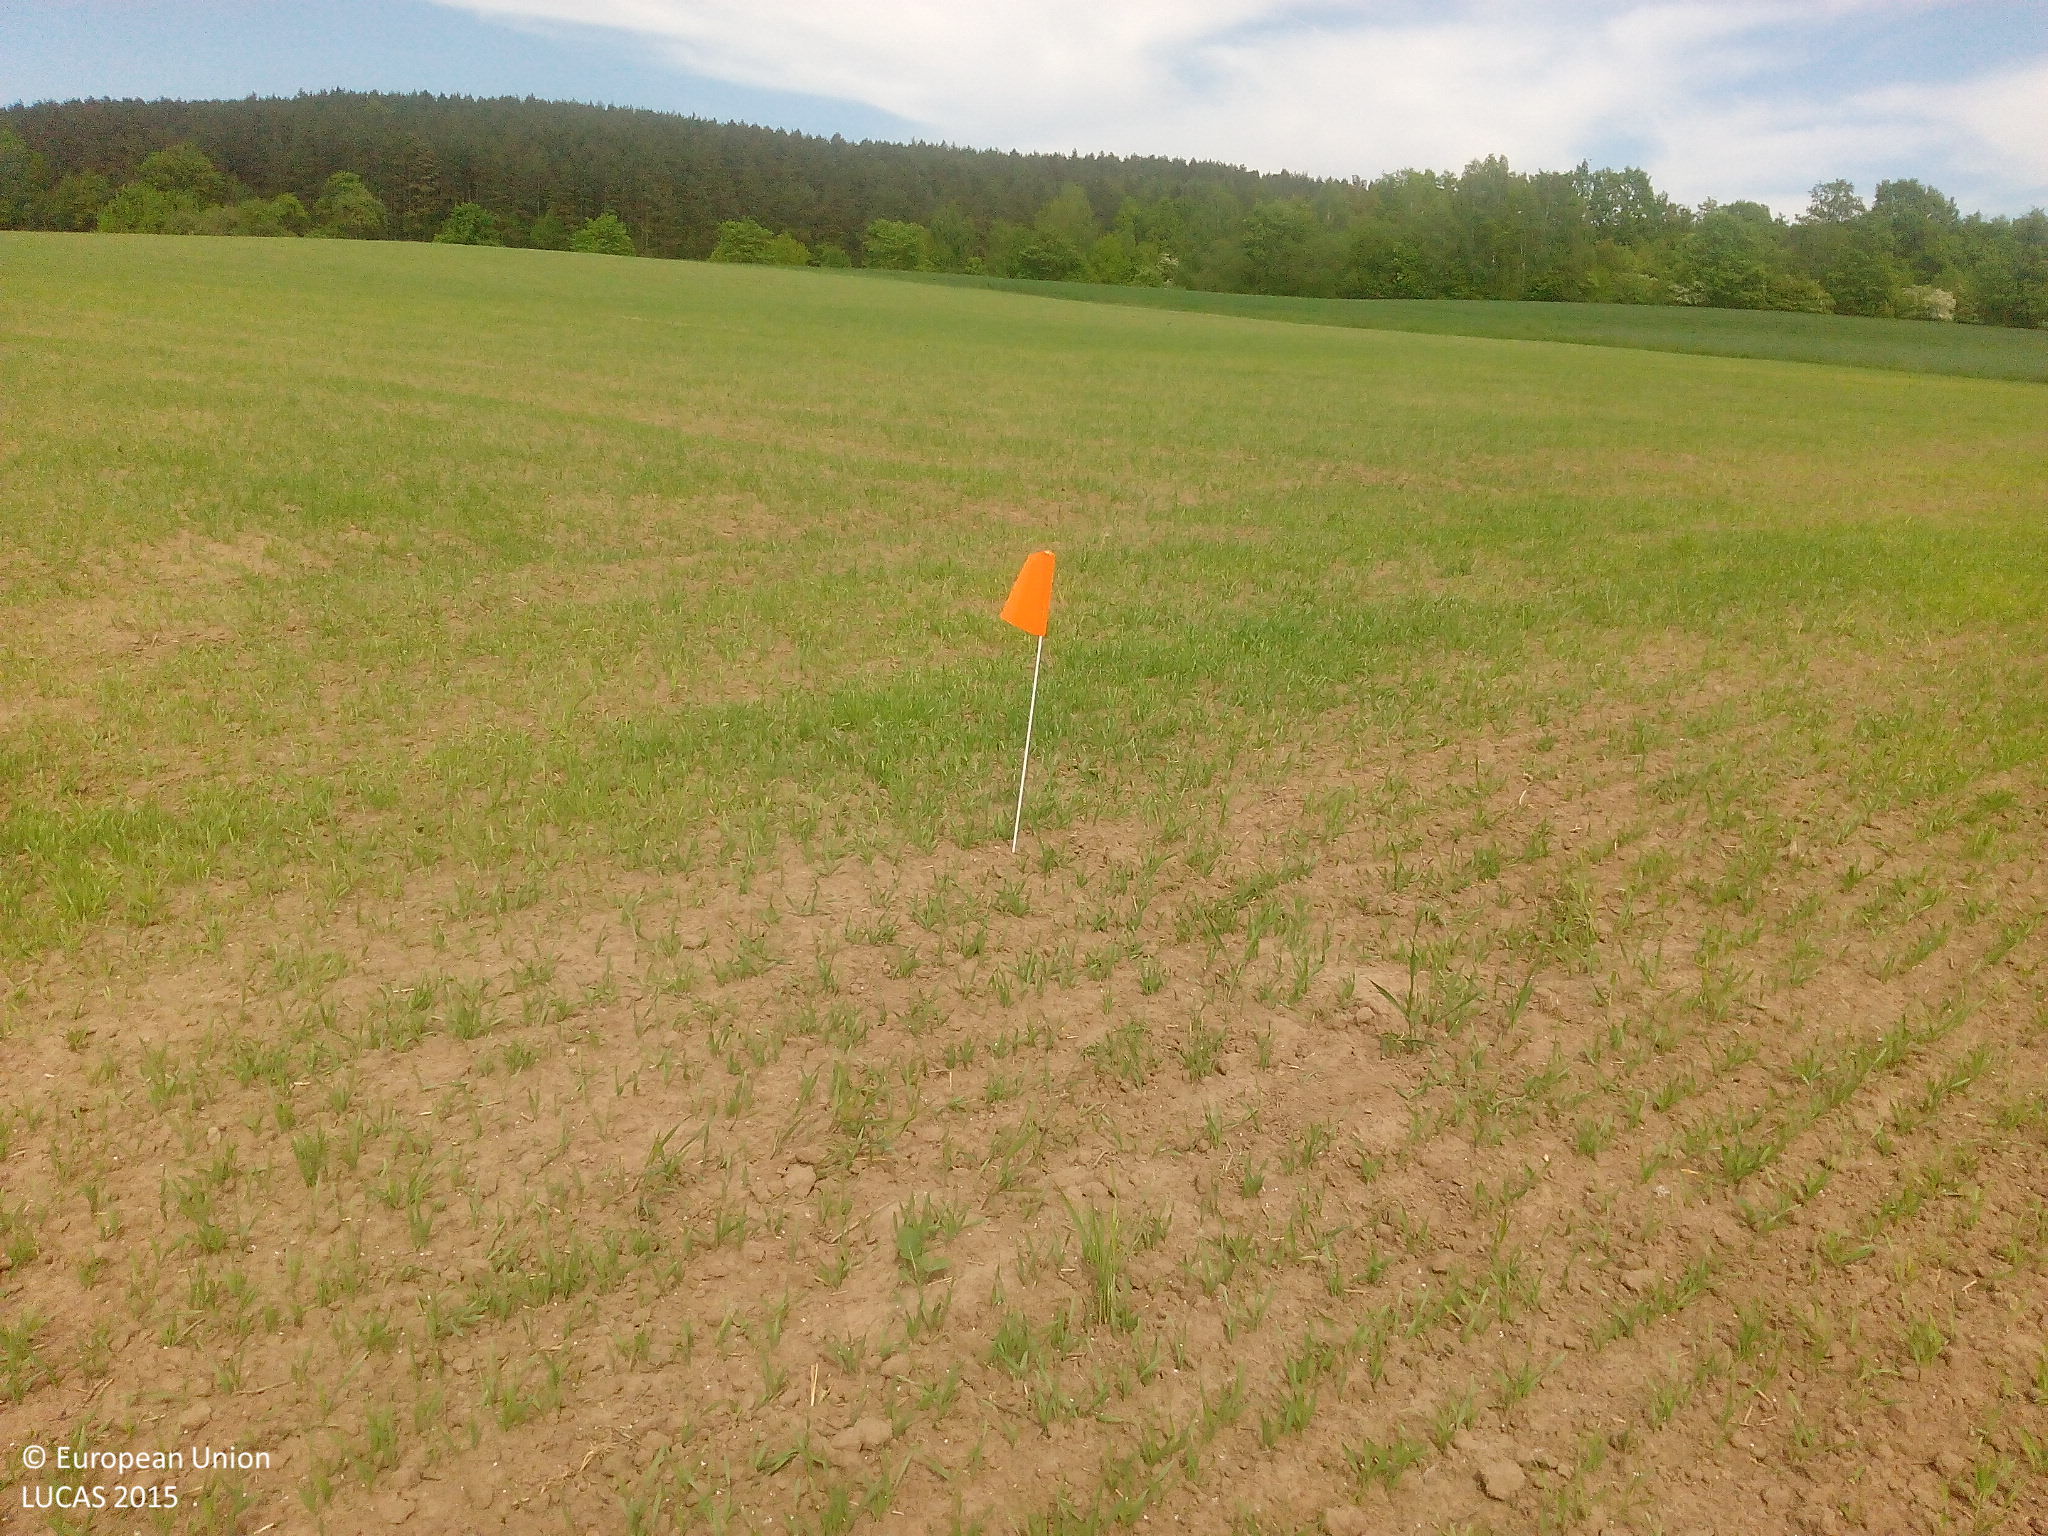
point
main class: Cropland
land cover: Common wheat
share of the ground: 25 - 50 %
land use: Agriculture (excluding fallow land and kitchen gardens)
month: May
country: DE
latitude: 50.0306
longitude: 11.4933
